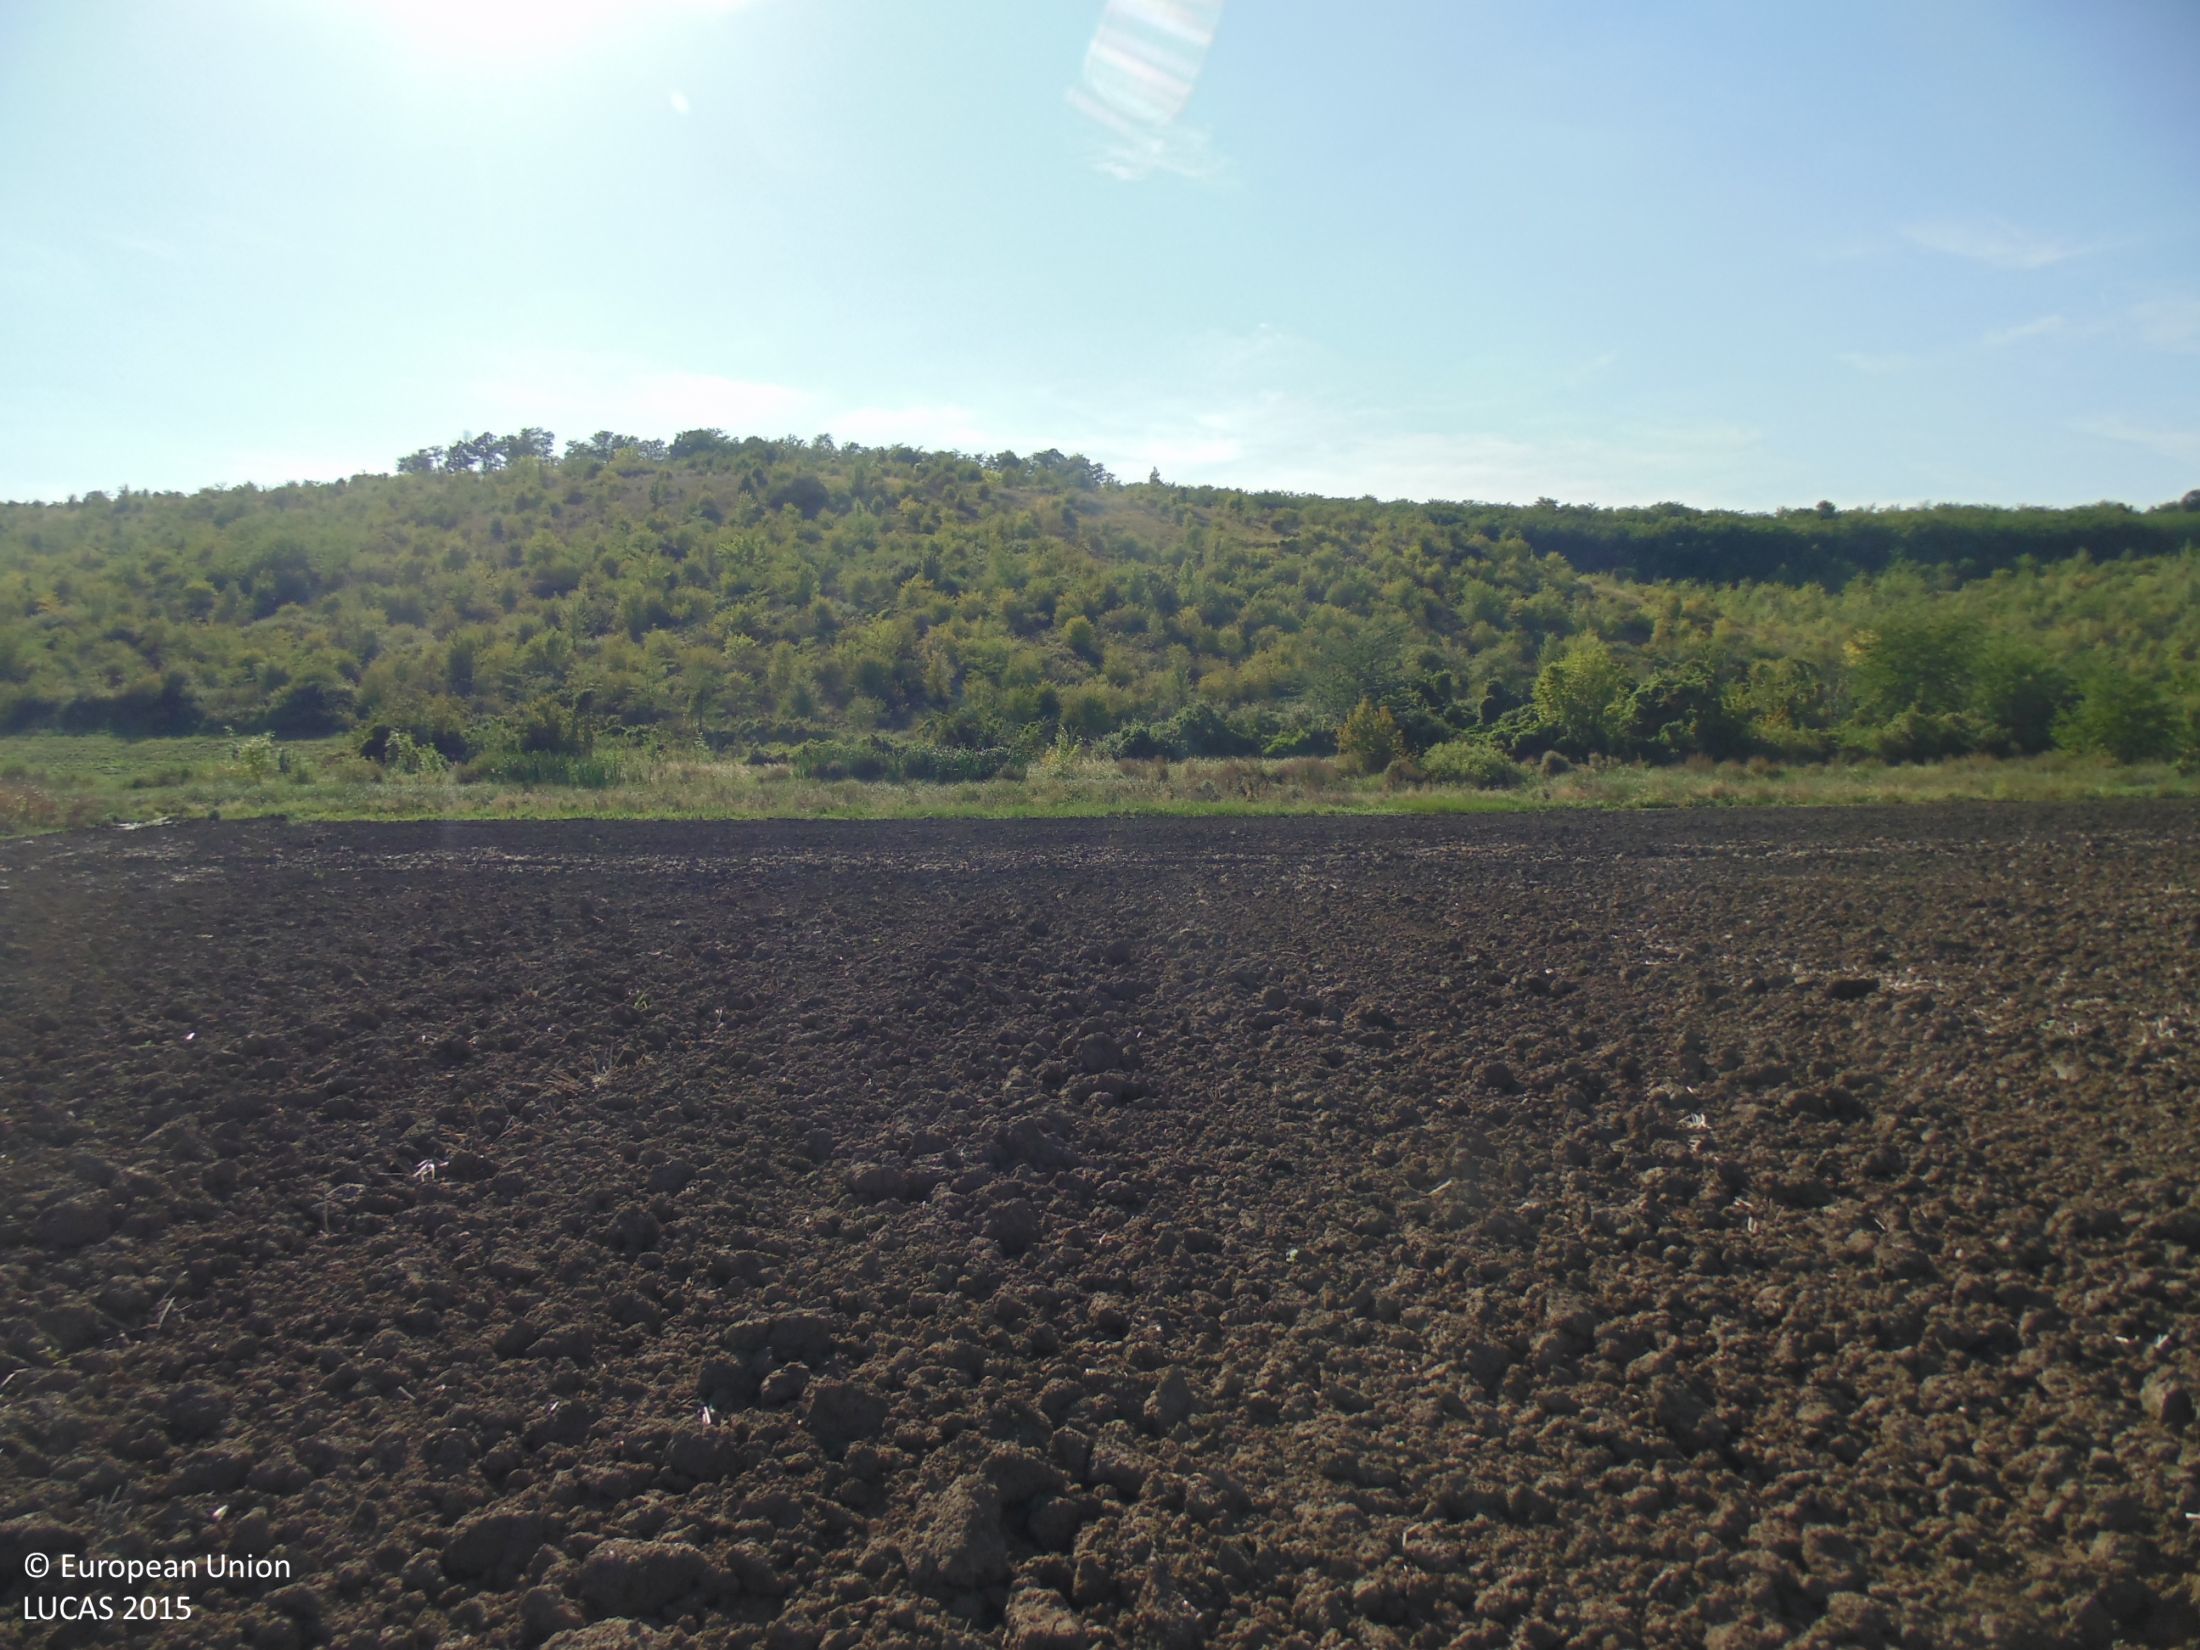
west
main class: Cropland
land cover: Common wheat
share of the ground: < 10 %
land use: Agriculture (excluding fallow land and kitchen gardens)
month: September
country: BG
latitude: 44.0461
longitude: 26.9590
